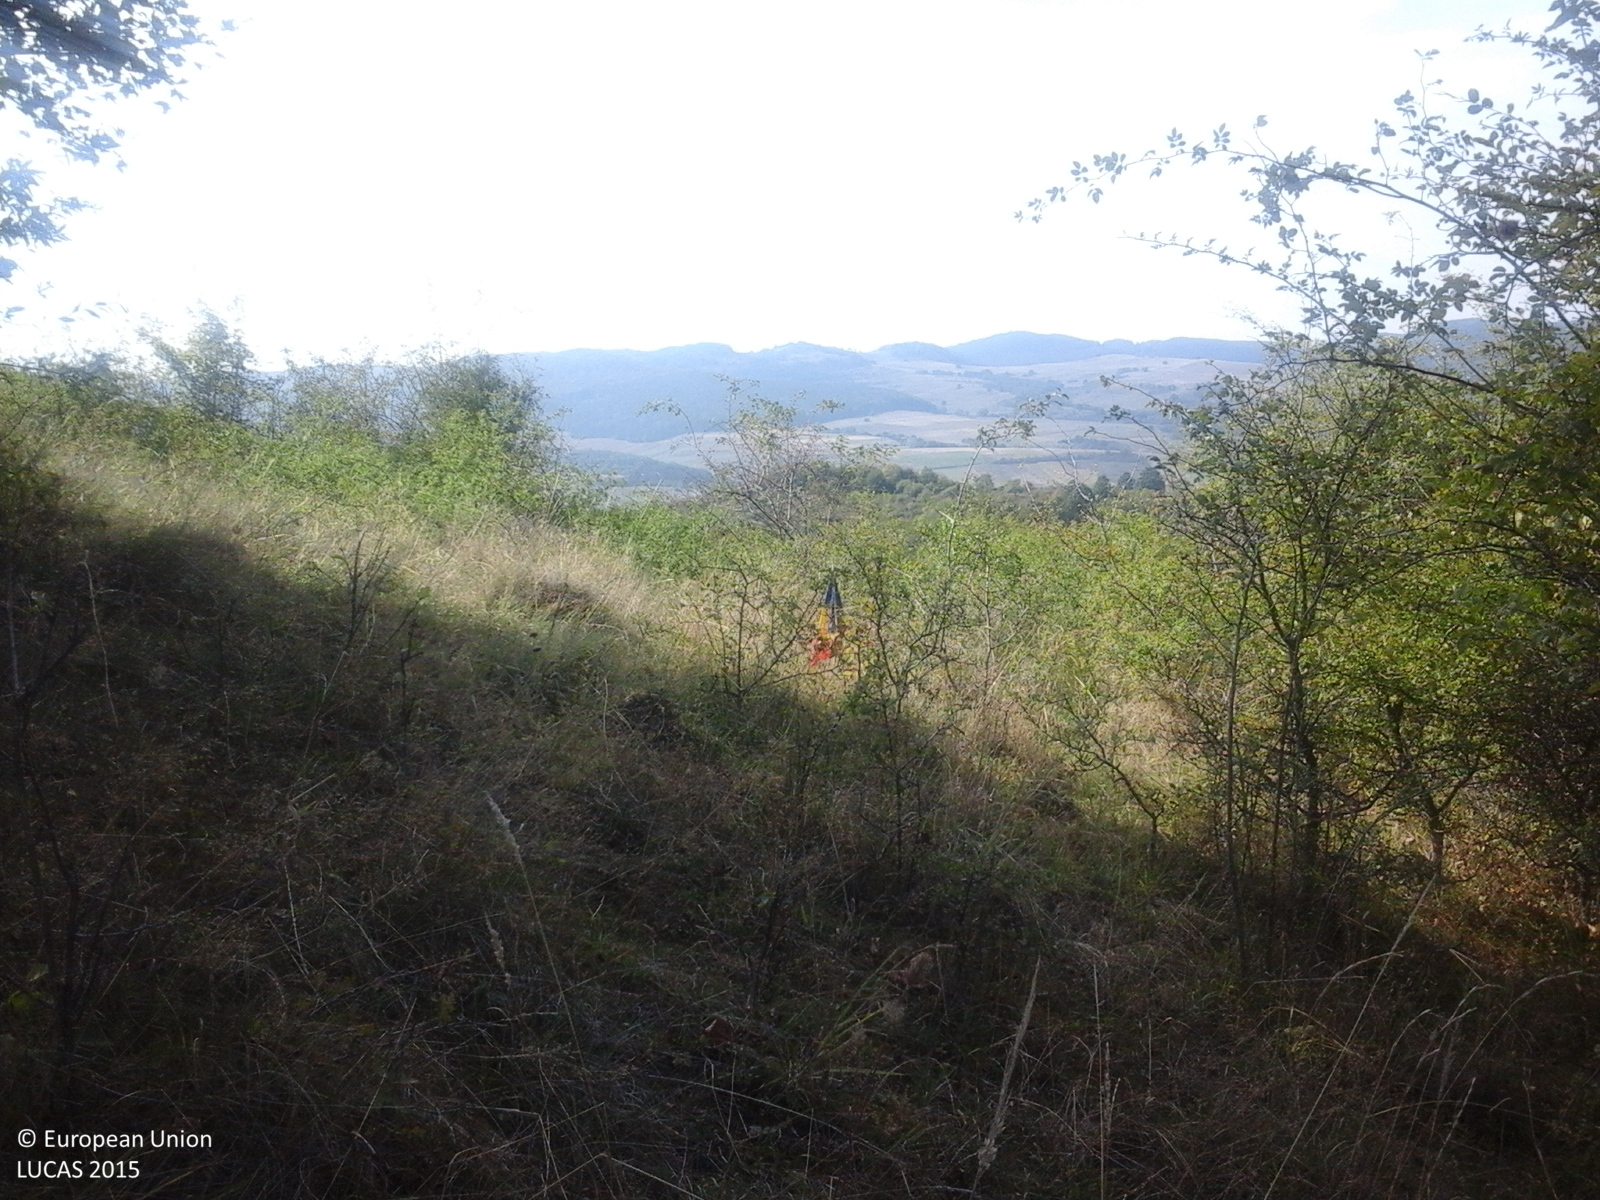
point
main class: Shrubland
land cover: Shrubland with sparse tree cover
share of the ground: > 75 %
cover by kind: shrubs 85 %, herbaceous plants 10 %, broadleaved forest trees 5 %
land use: Semi-natural and natural areas not in use
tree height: < 5 m
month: September
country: RO
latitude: 47.1420
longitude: 23.4279
